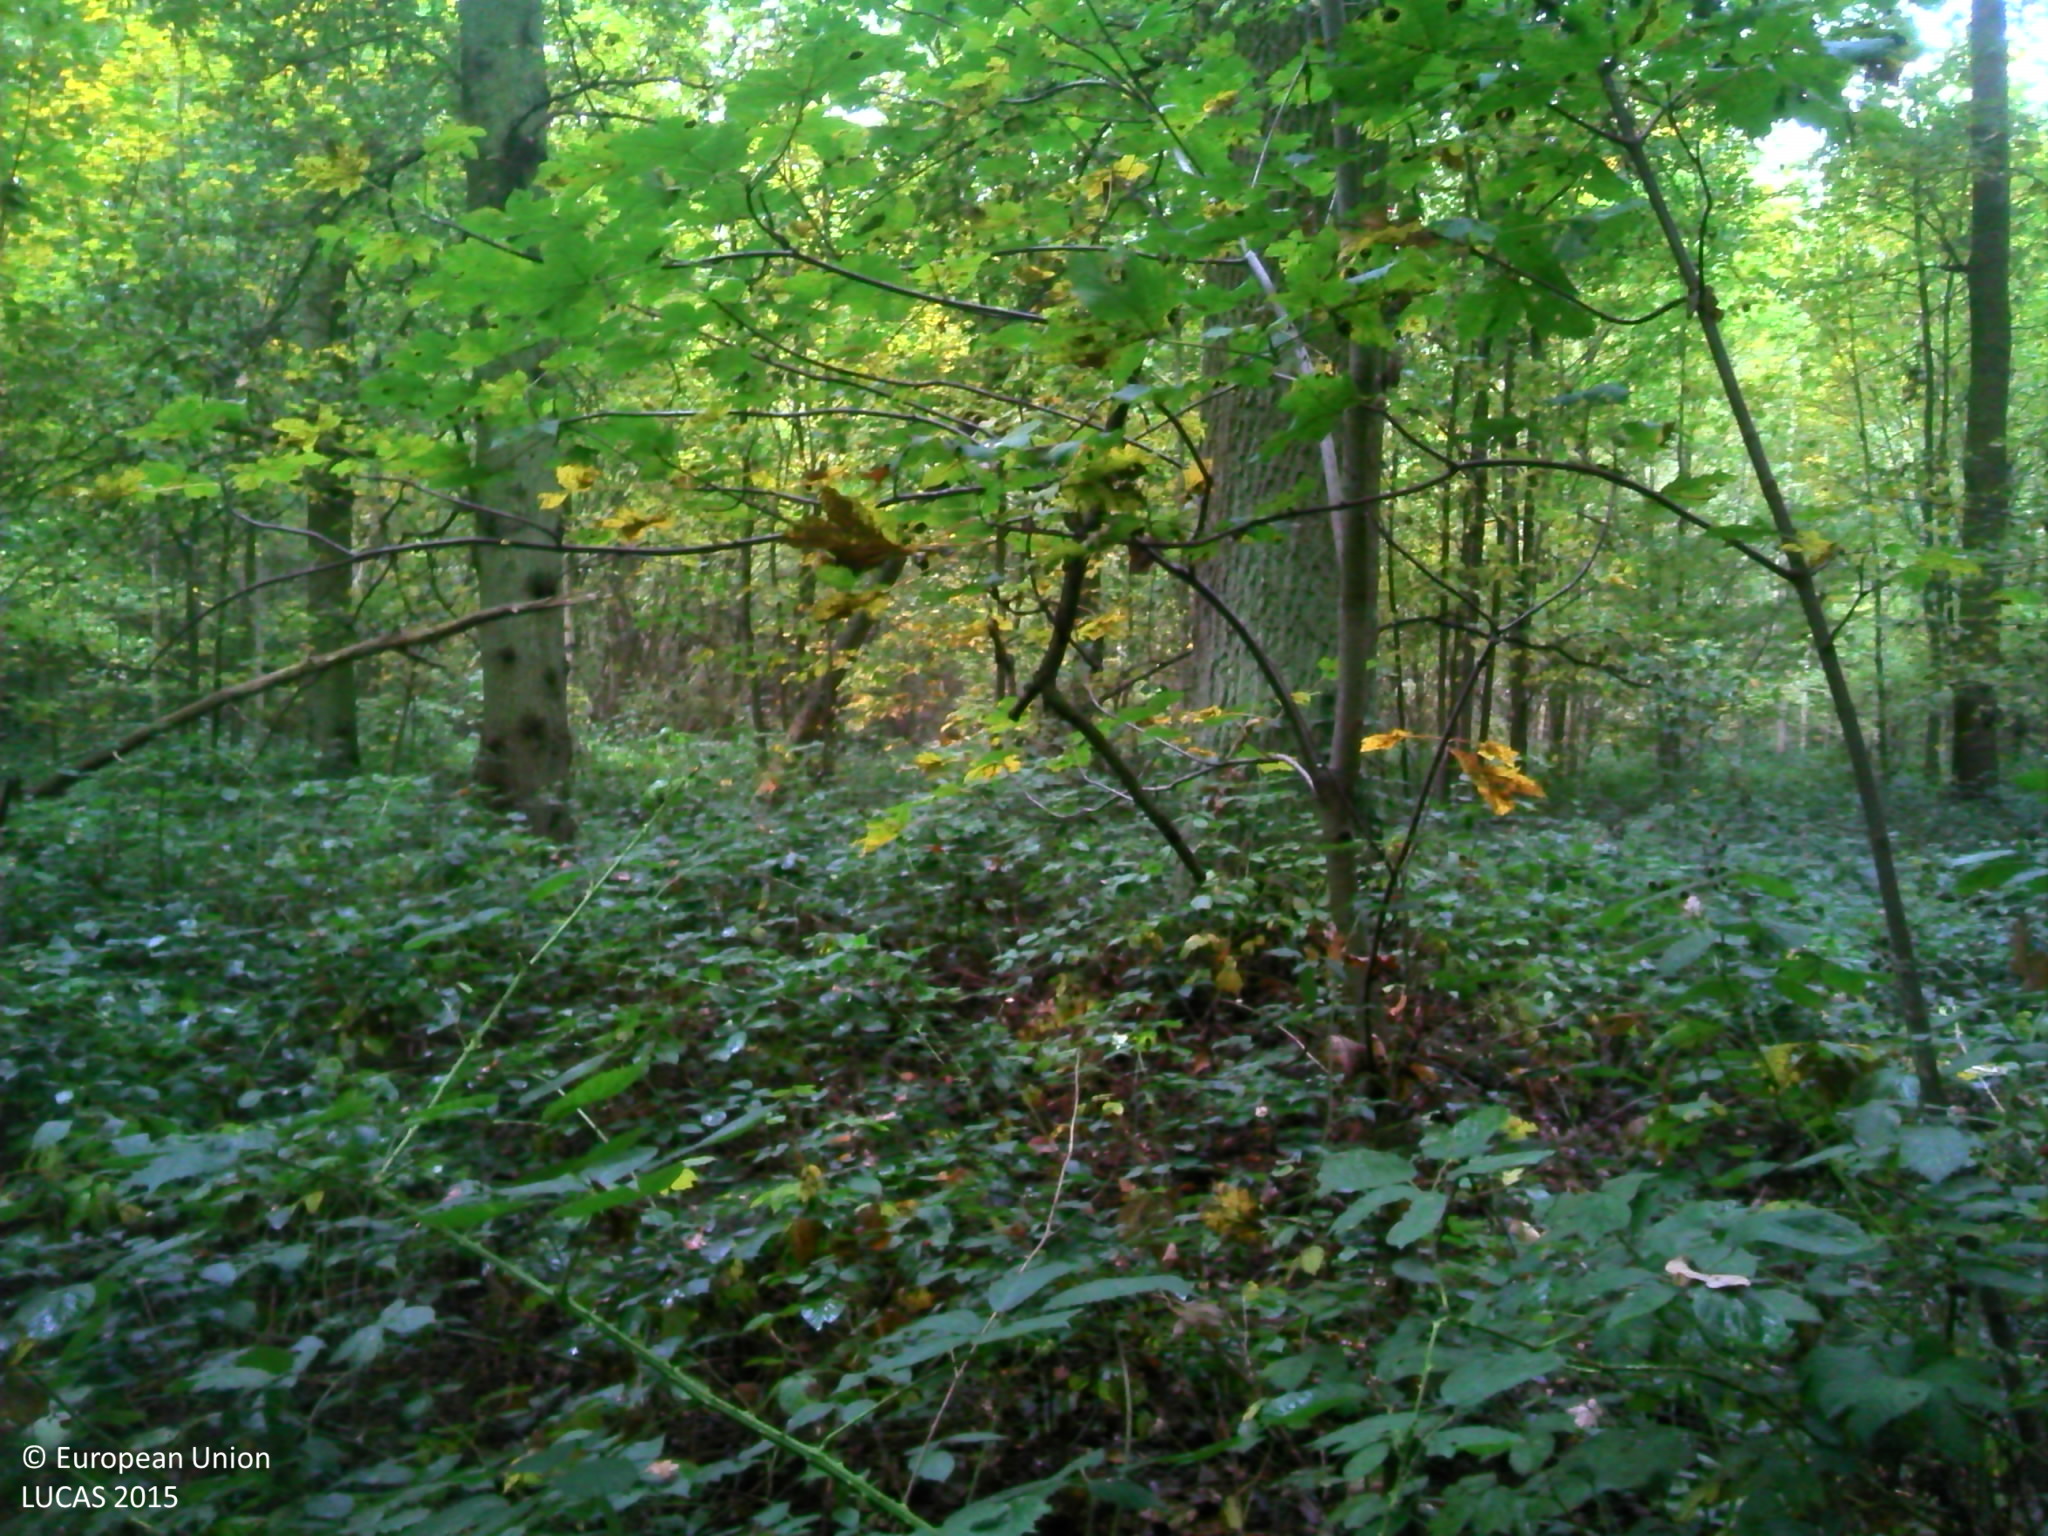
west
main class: Woodland
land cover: Broadleaved woodland
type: mesophytic deciduous forest
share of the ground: > 75 %
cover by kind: broadleaved forest trees 95 %, herbaceous plants 5 %
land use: Forestry
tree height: > 5 m
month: October
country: BE
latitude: 50.9355
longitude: 4.5173
